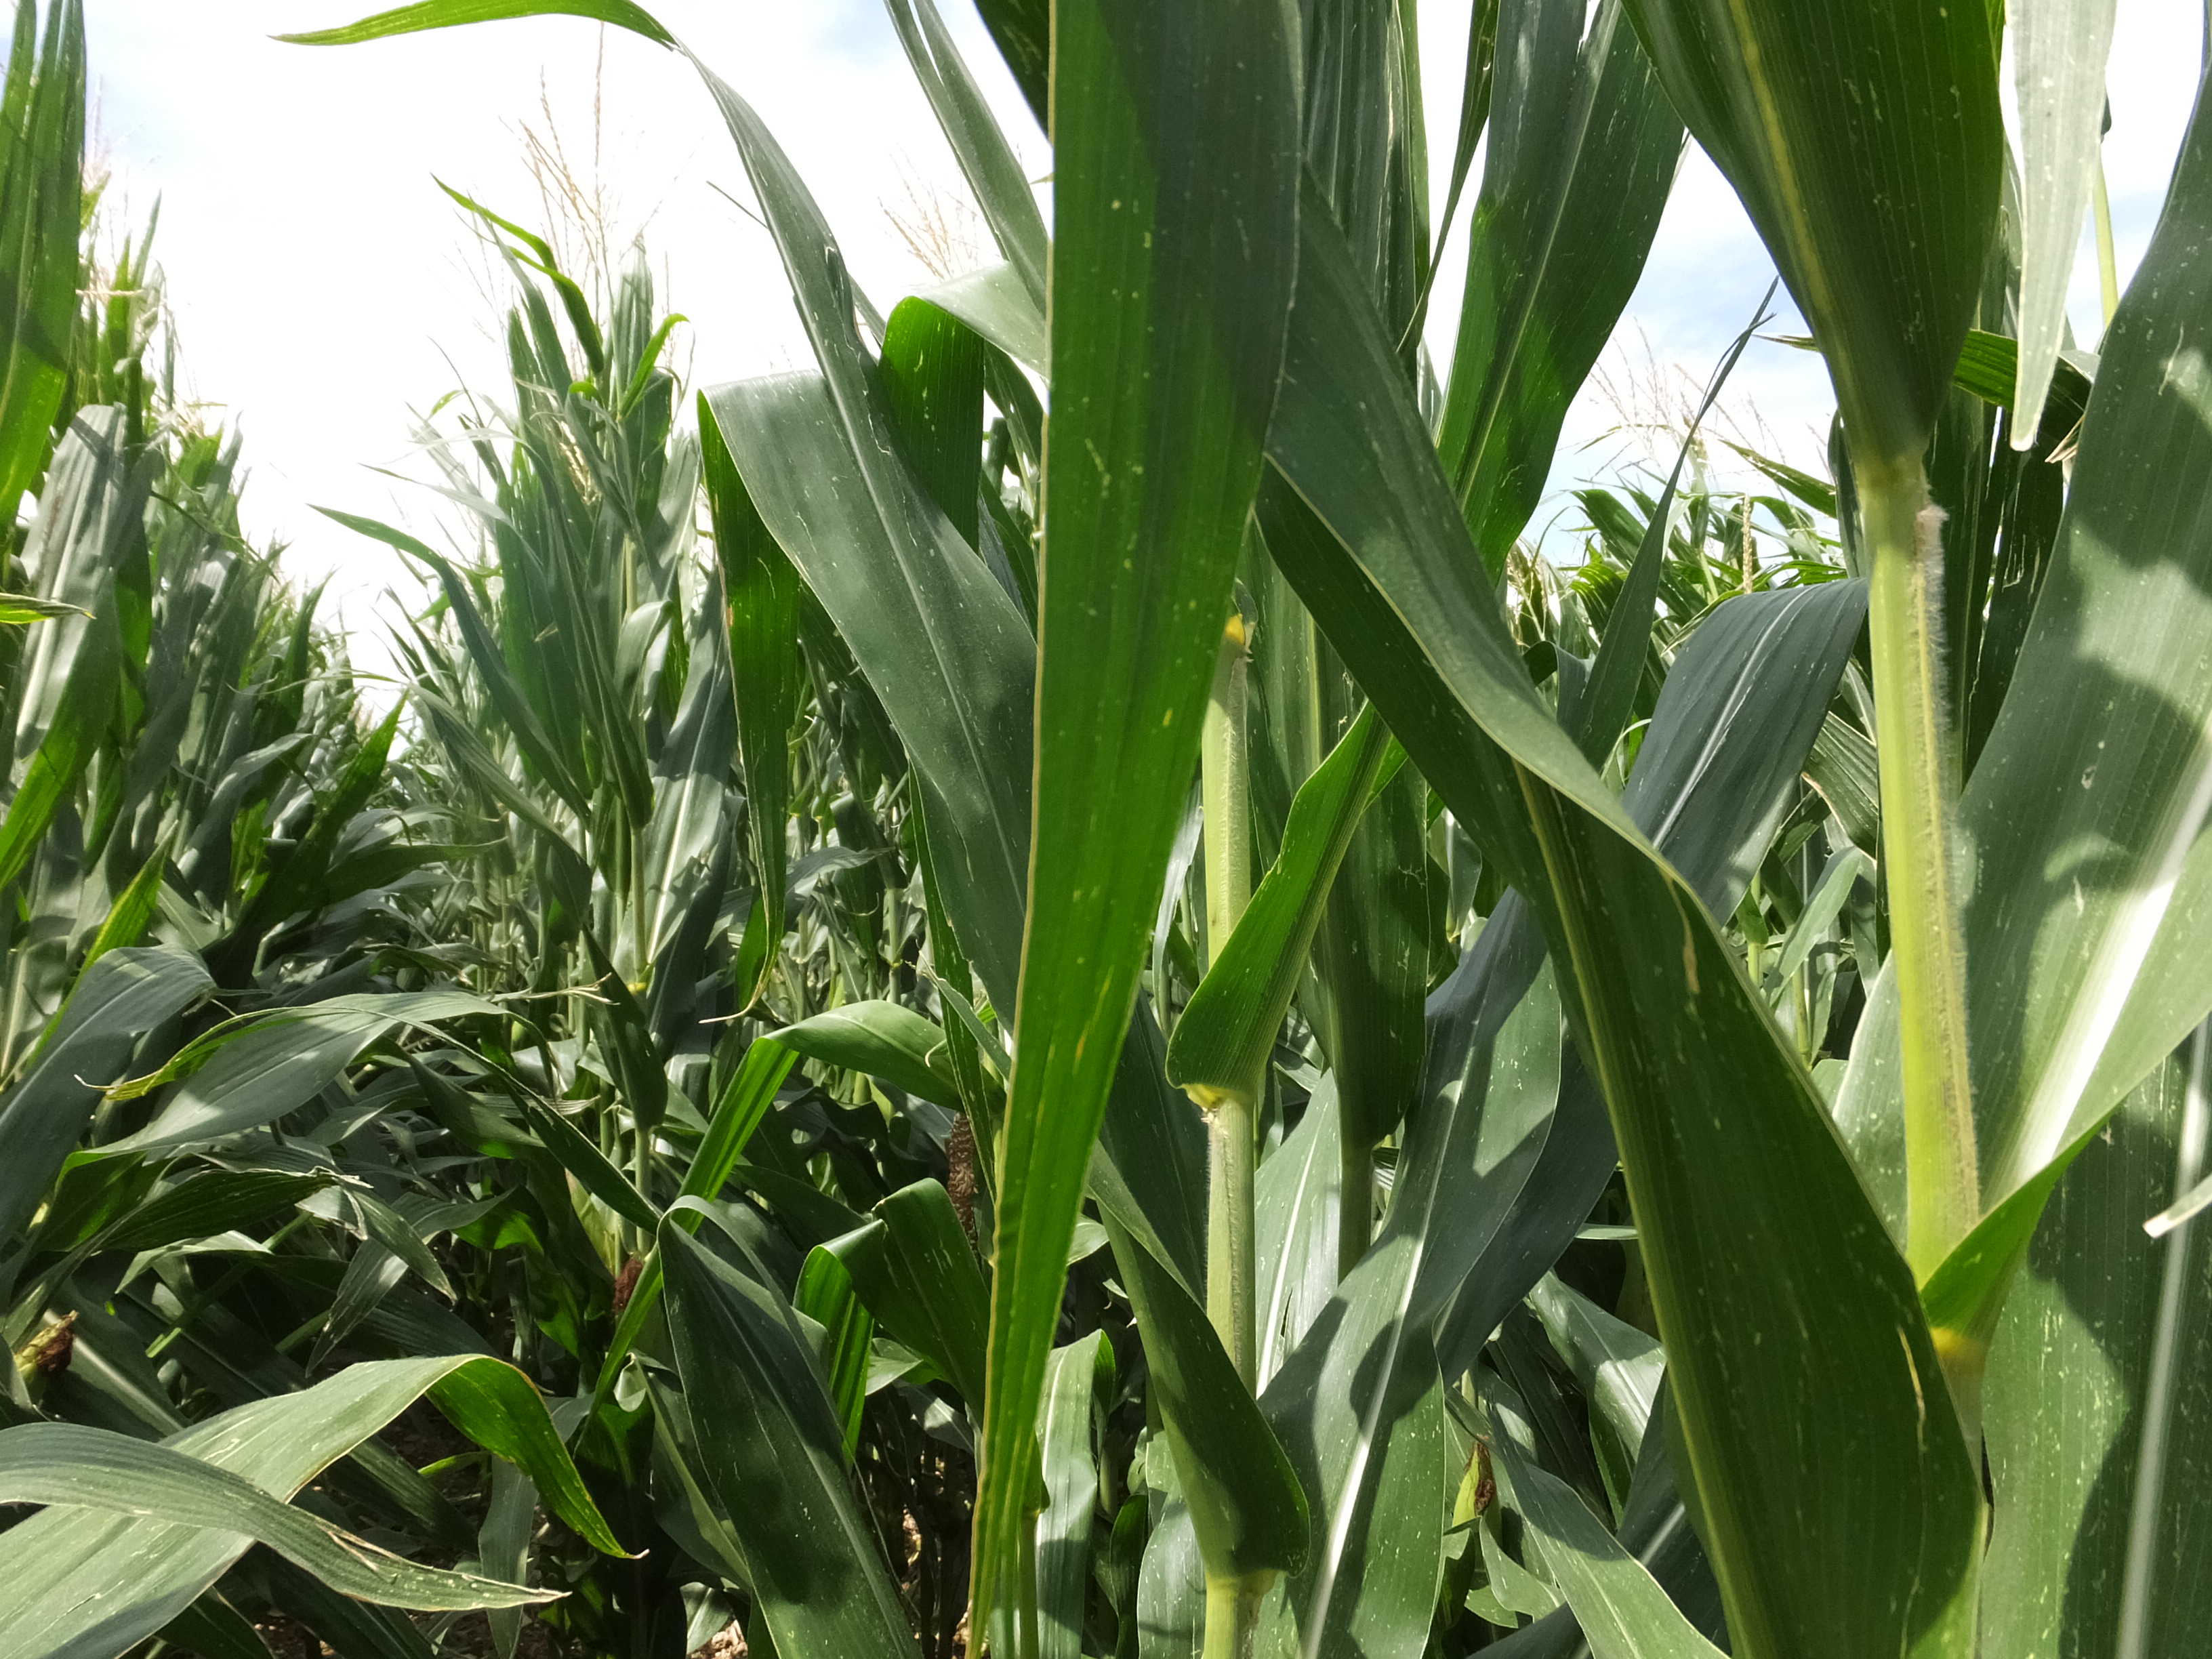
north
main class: Cropland
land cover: Maize
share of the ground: > 75 %
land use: Agriculture (excluding fallow land and kitchen gardens)
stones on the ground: < 10 %
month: August
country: ES
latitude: 41.5132
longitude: 0.1008
